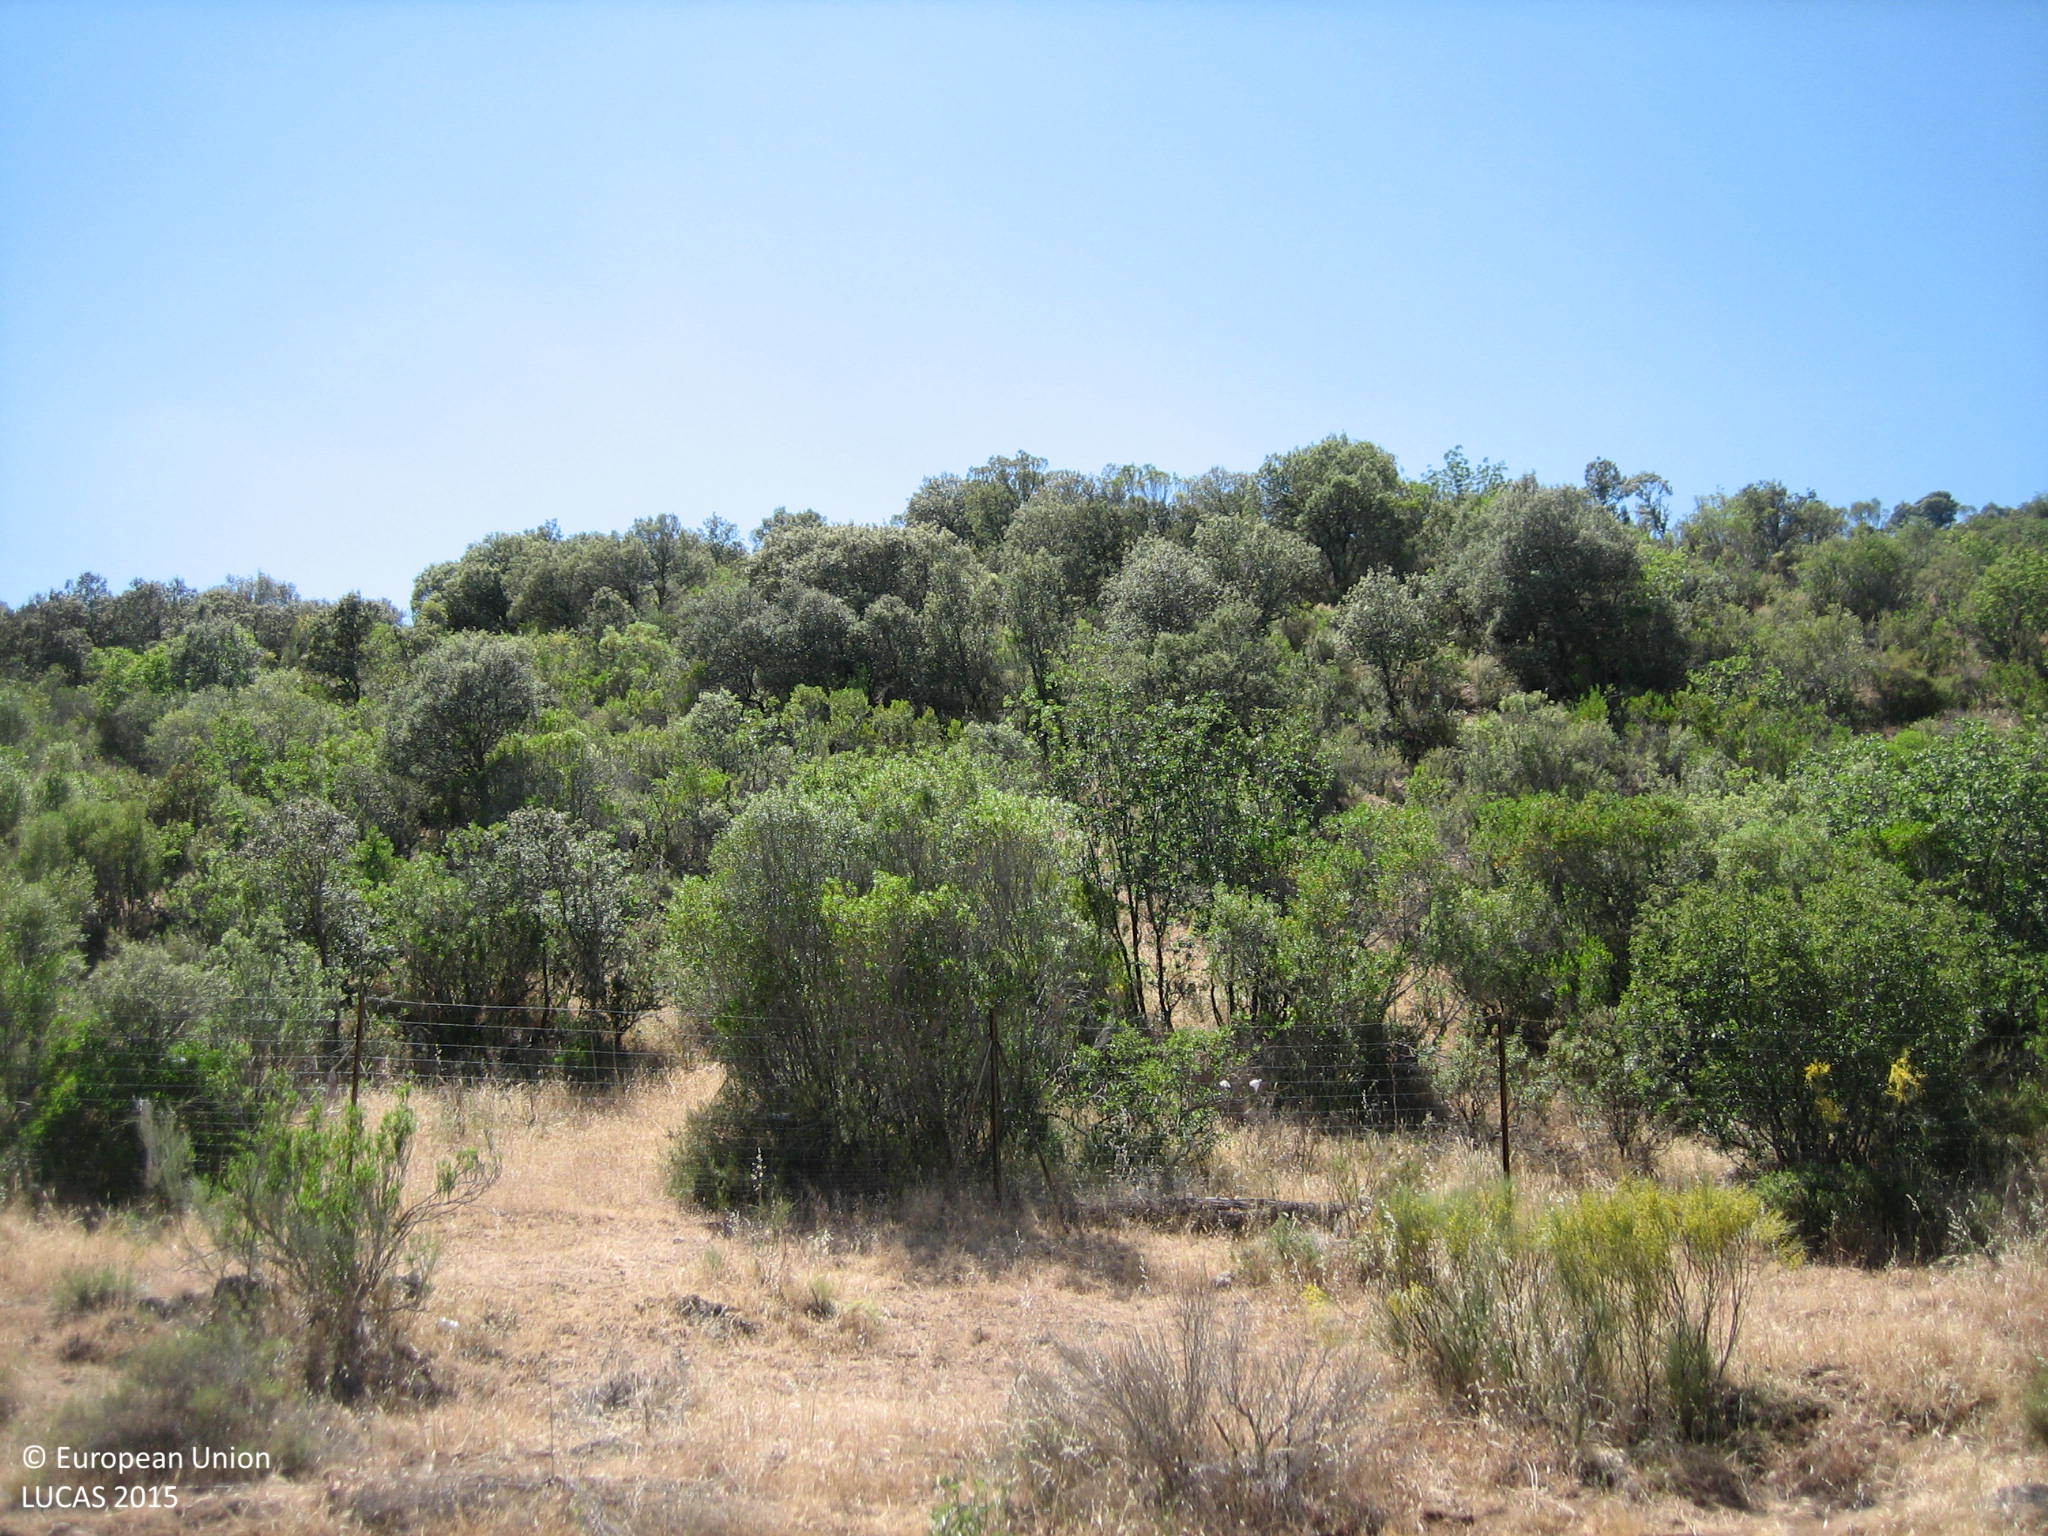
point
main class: Woodland
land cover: Broadleaved woodland
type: broadleaved evergreen forest
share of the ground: > 75 %
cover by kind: shrubs 80 %, broadleaved forest trees 20 %
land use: Forestry
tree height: < 5 m
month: May
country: ES
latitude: 38.4569
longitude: -3.9593
